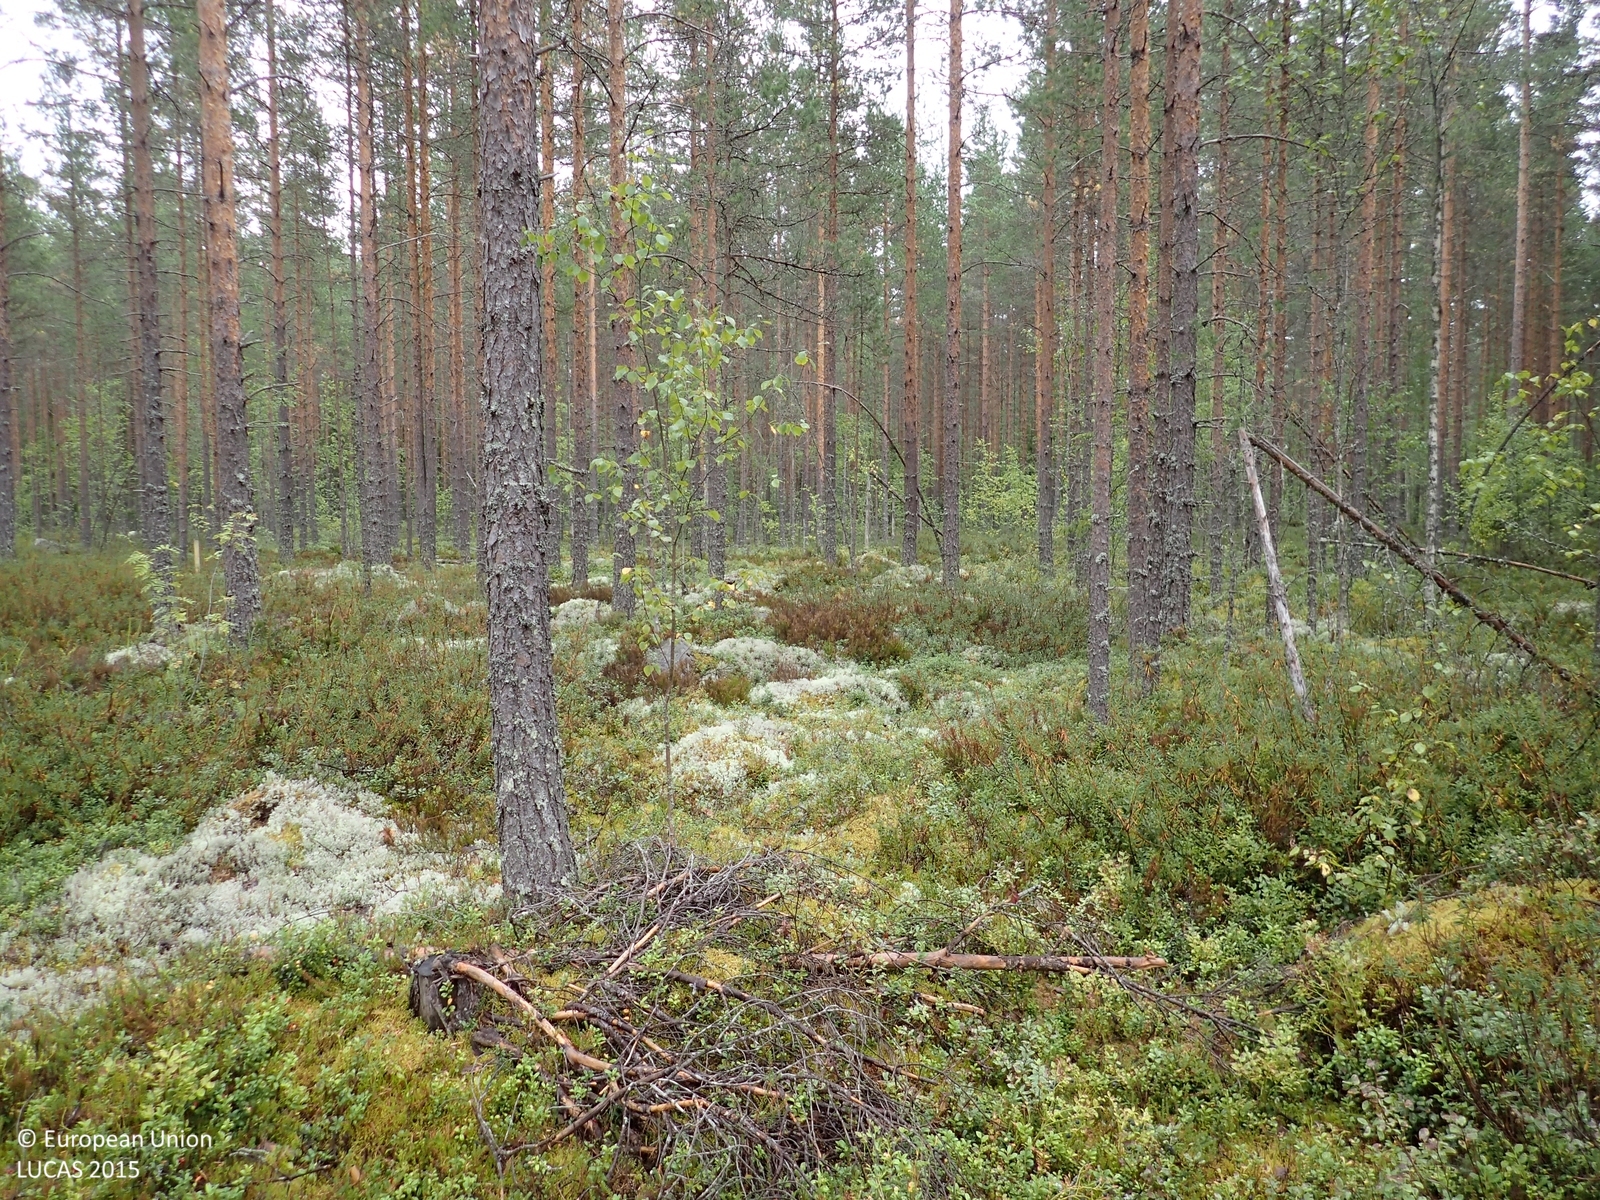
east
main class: Woodland
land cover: Pine dominated coniferous woodland
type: boreal forest
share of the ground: 50 - 75 %
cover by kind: coniferous forest trees 60 %, shrubs 25 %, lichens and mosses 10 %, broadleaved forest trees 5 %
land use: Forestry
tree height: > 5 m
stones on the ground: < 10 %
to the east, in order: Pine dominated coniferous woodland; Pine dominated mixed woodland; Ditches and canals; Grass margins; Paved roads, cycling and walking lanes; Grass margins; Ditches and canals; Pine dominated mixed woodland; Ditches and canals; Pine dominated mixed woodland
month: August
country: FI
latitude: 62.6692
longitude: 23.2039
